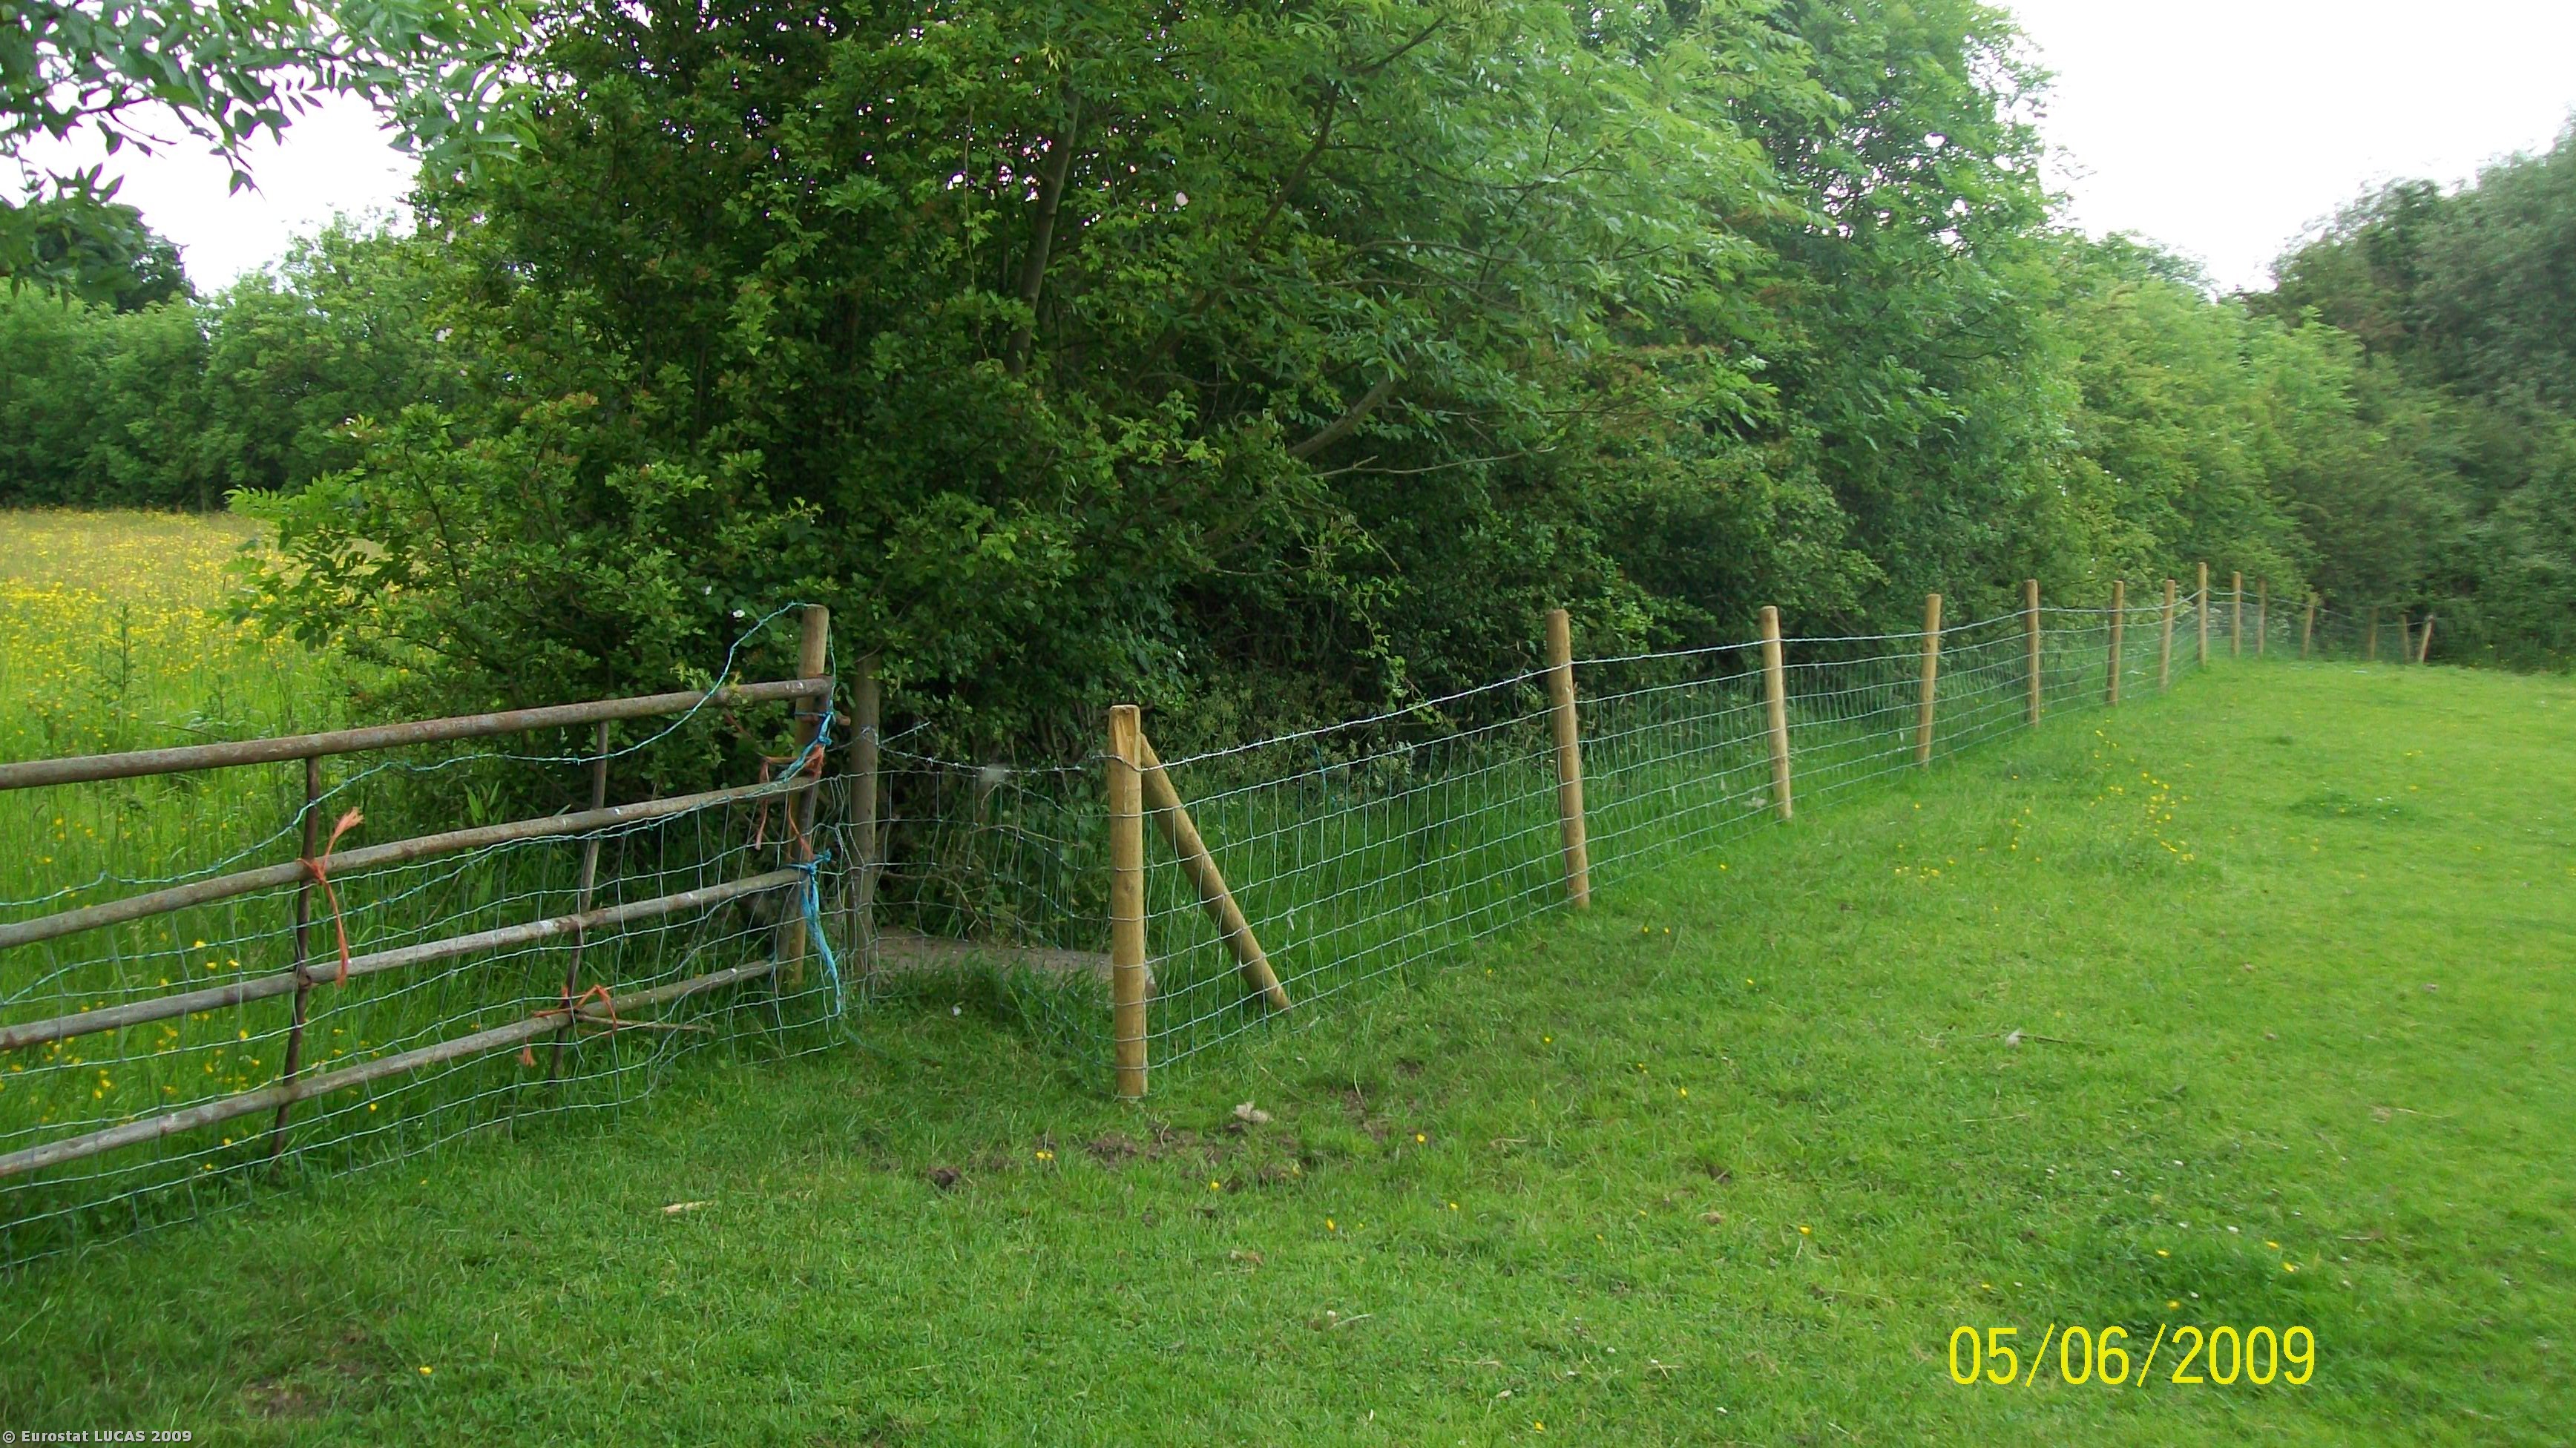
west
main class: Grassland
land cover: Grassland without tree/shrub cover
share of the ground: > 75 %
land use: Agriculture (excluding fallow land and kitchen gardens)
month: June
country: GB
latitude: 53.1243
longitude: -2.7574
